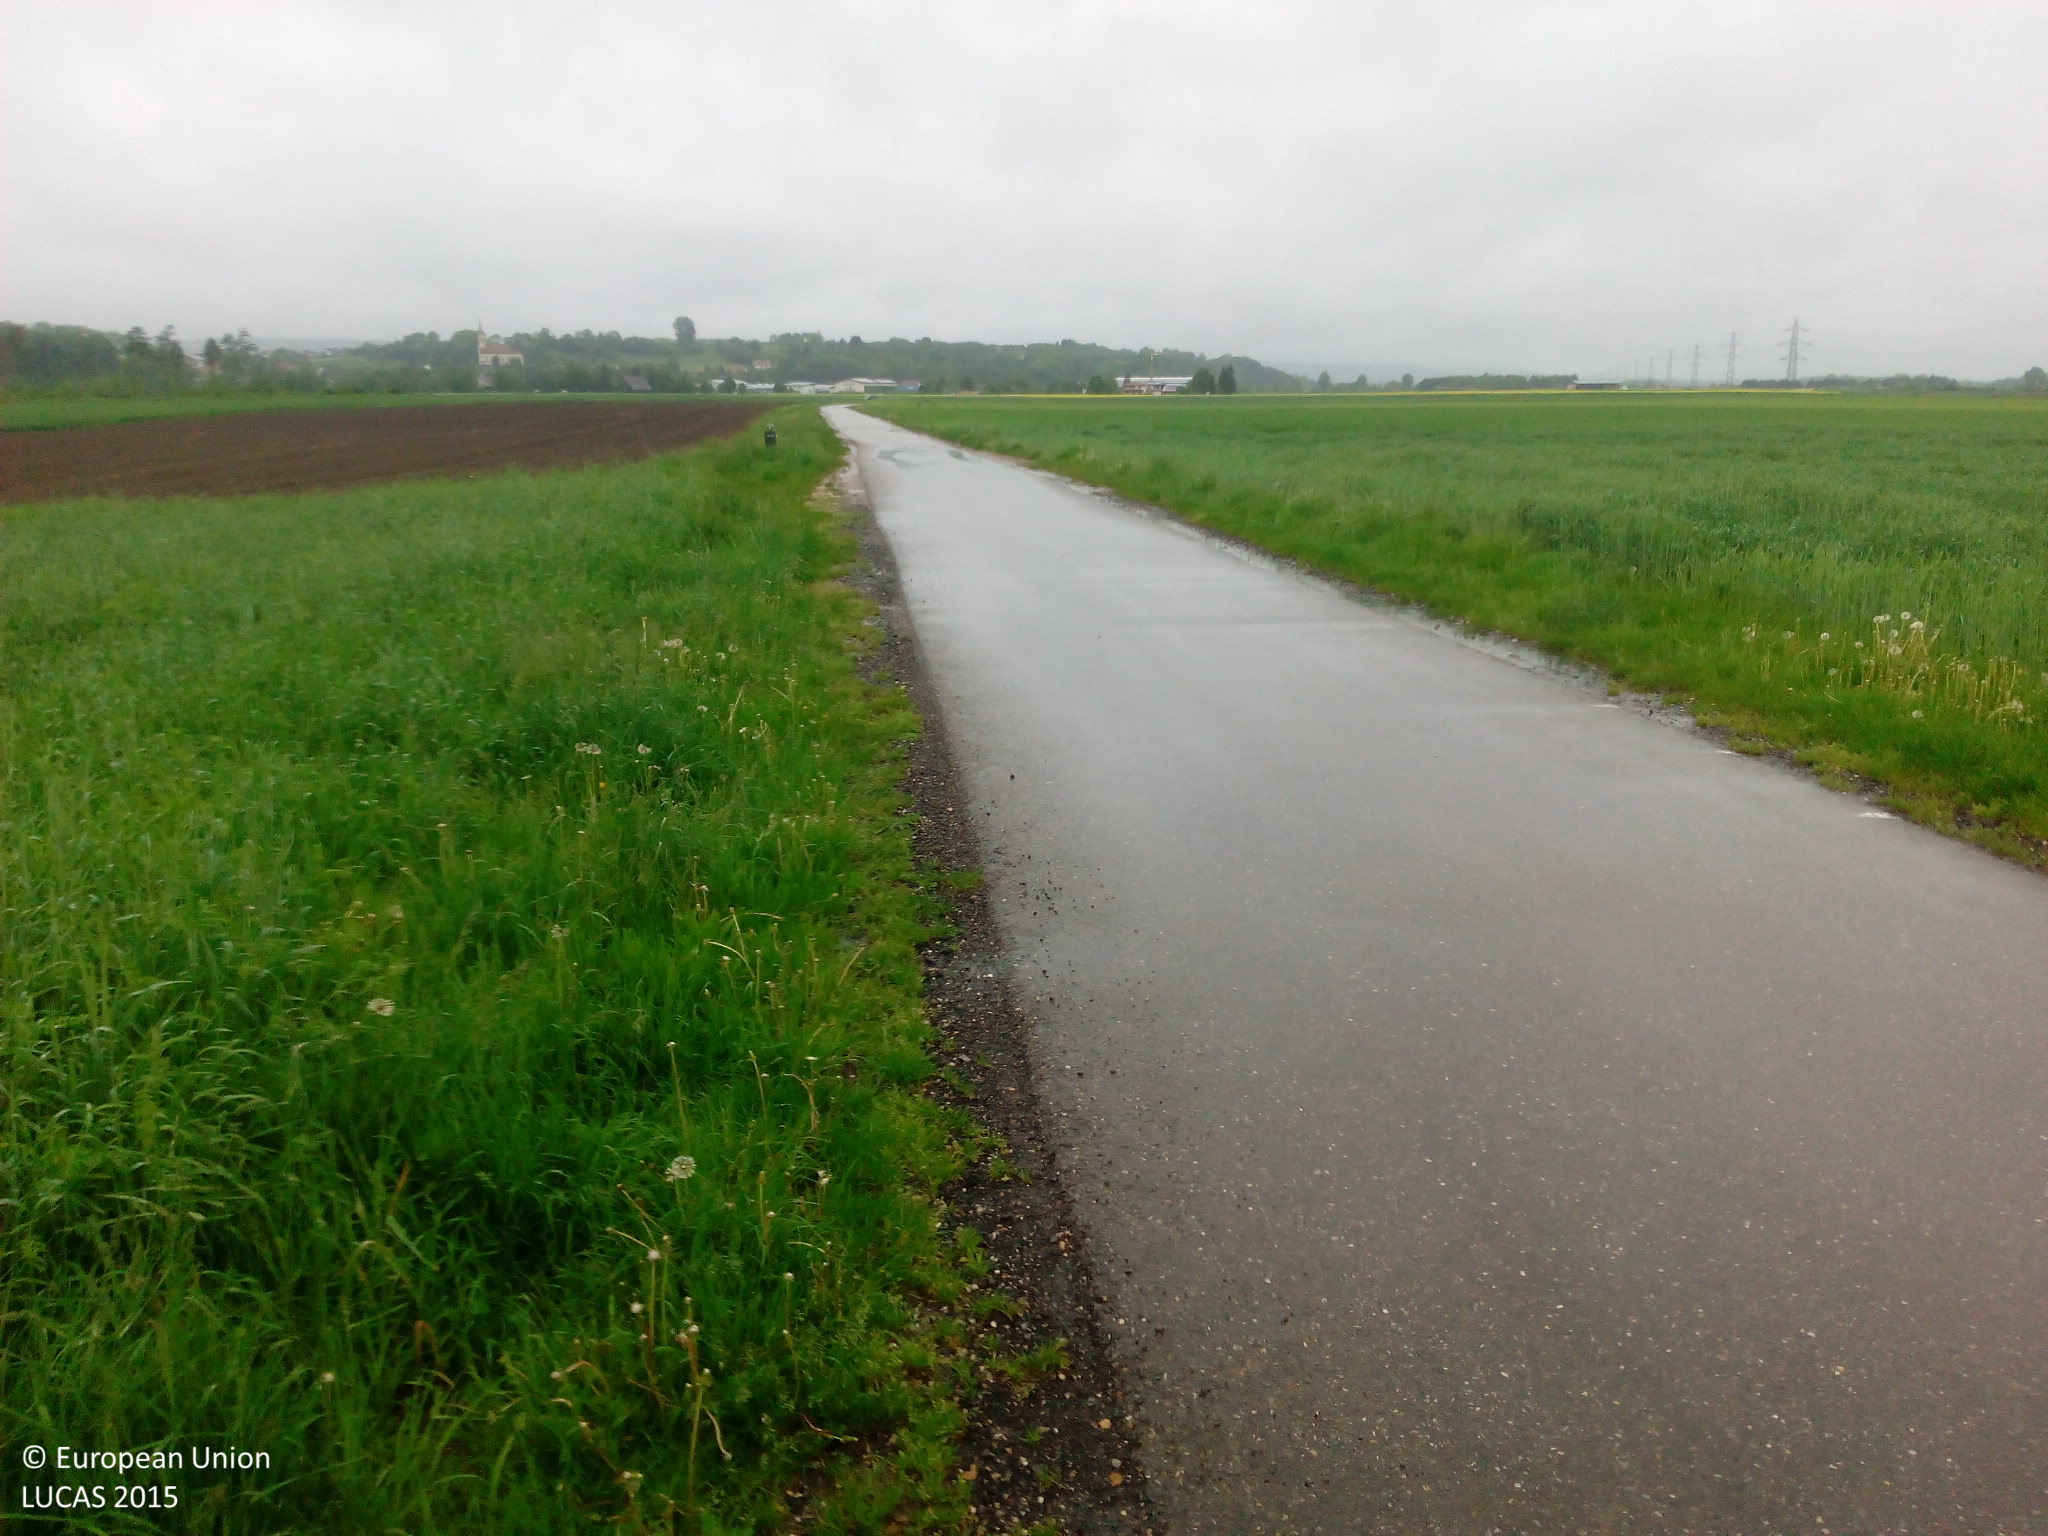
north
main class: Cropland
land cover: Rye
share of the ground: > 75 %
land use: Agriculture (excluding fallow land and kitchen gardens)
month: May
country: DE
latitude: 48.0960
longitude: 9.4230
